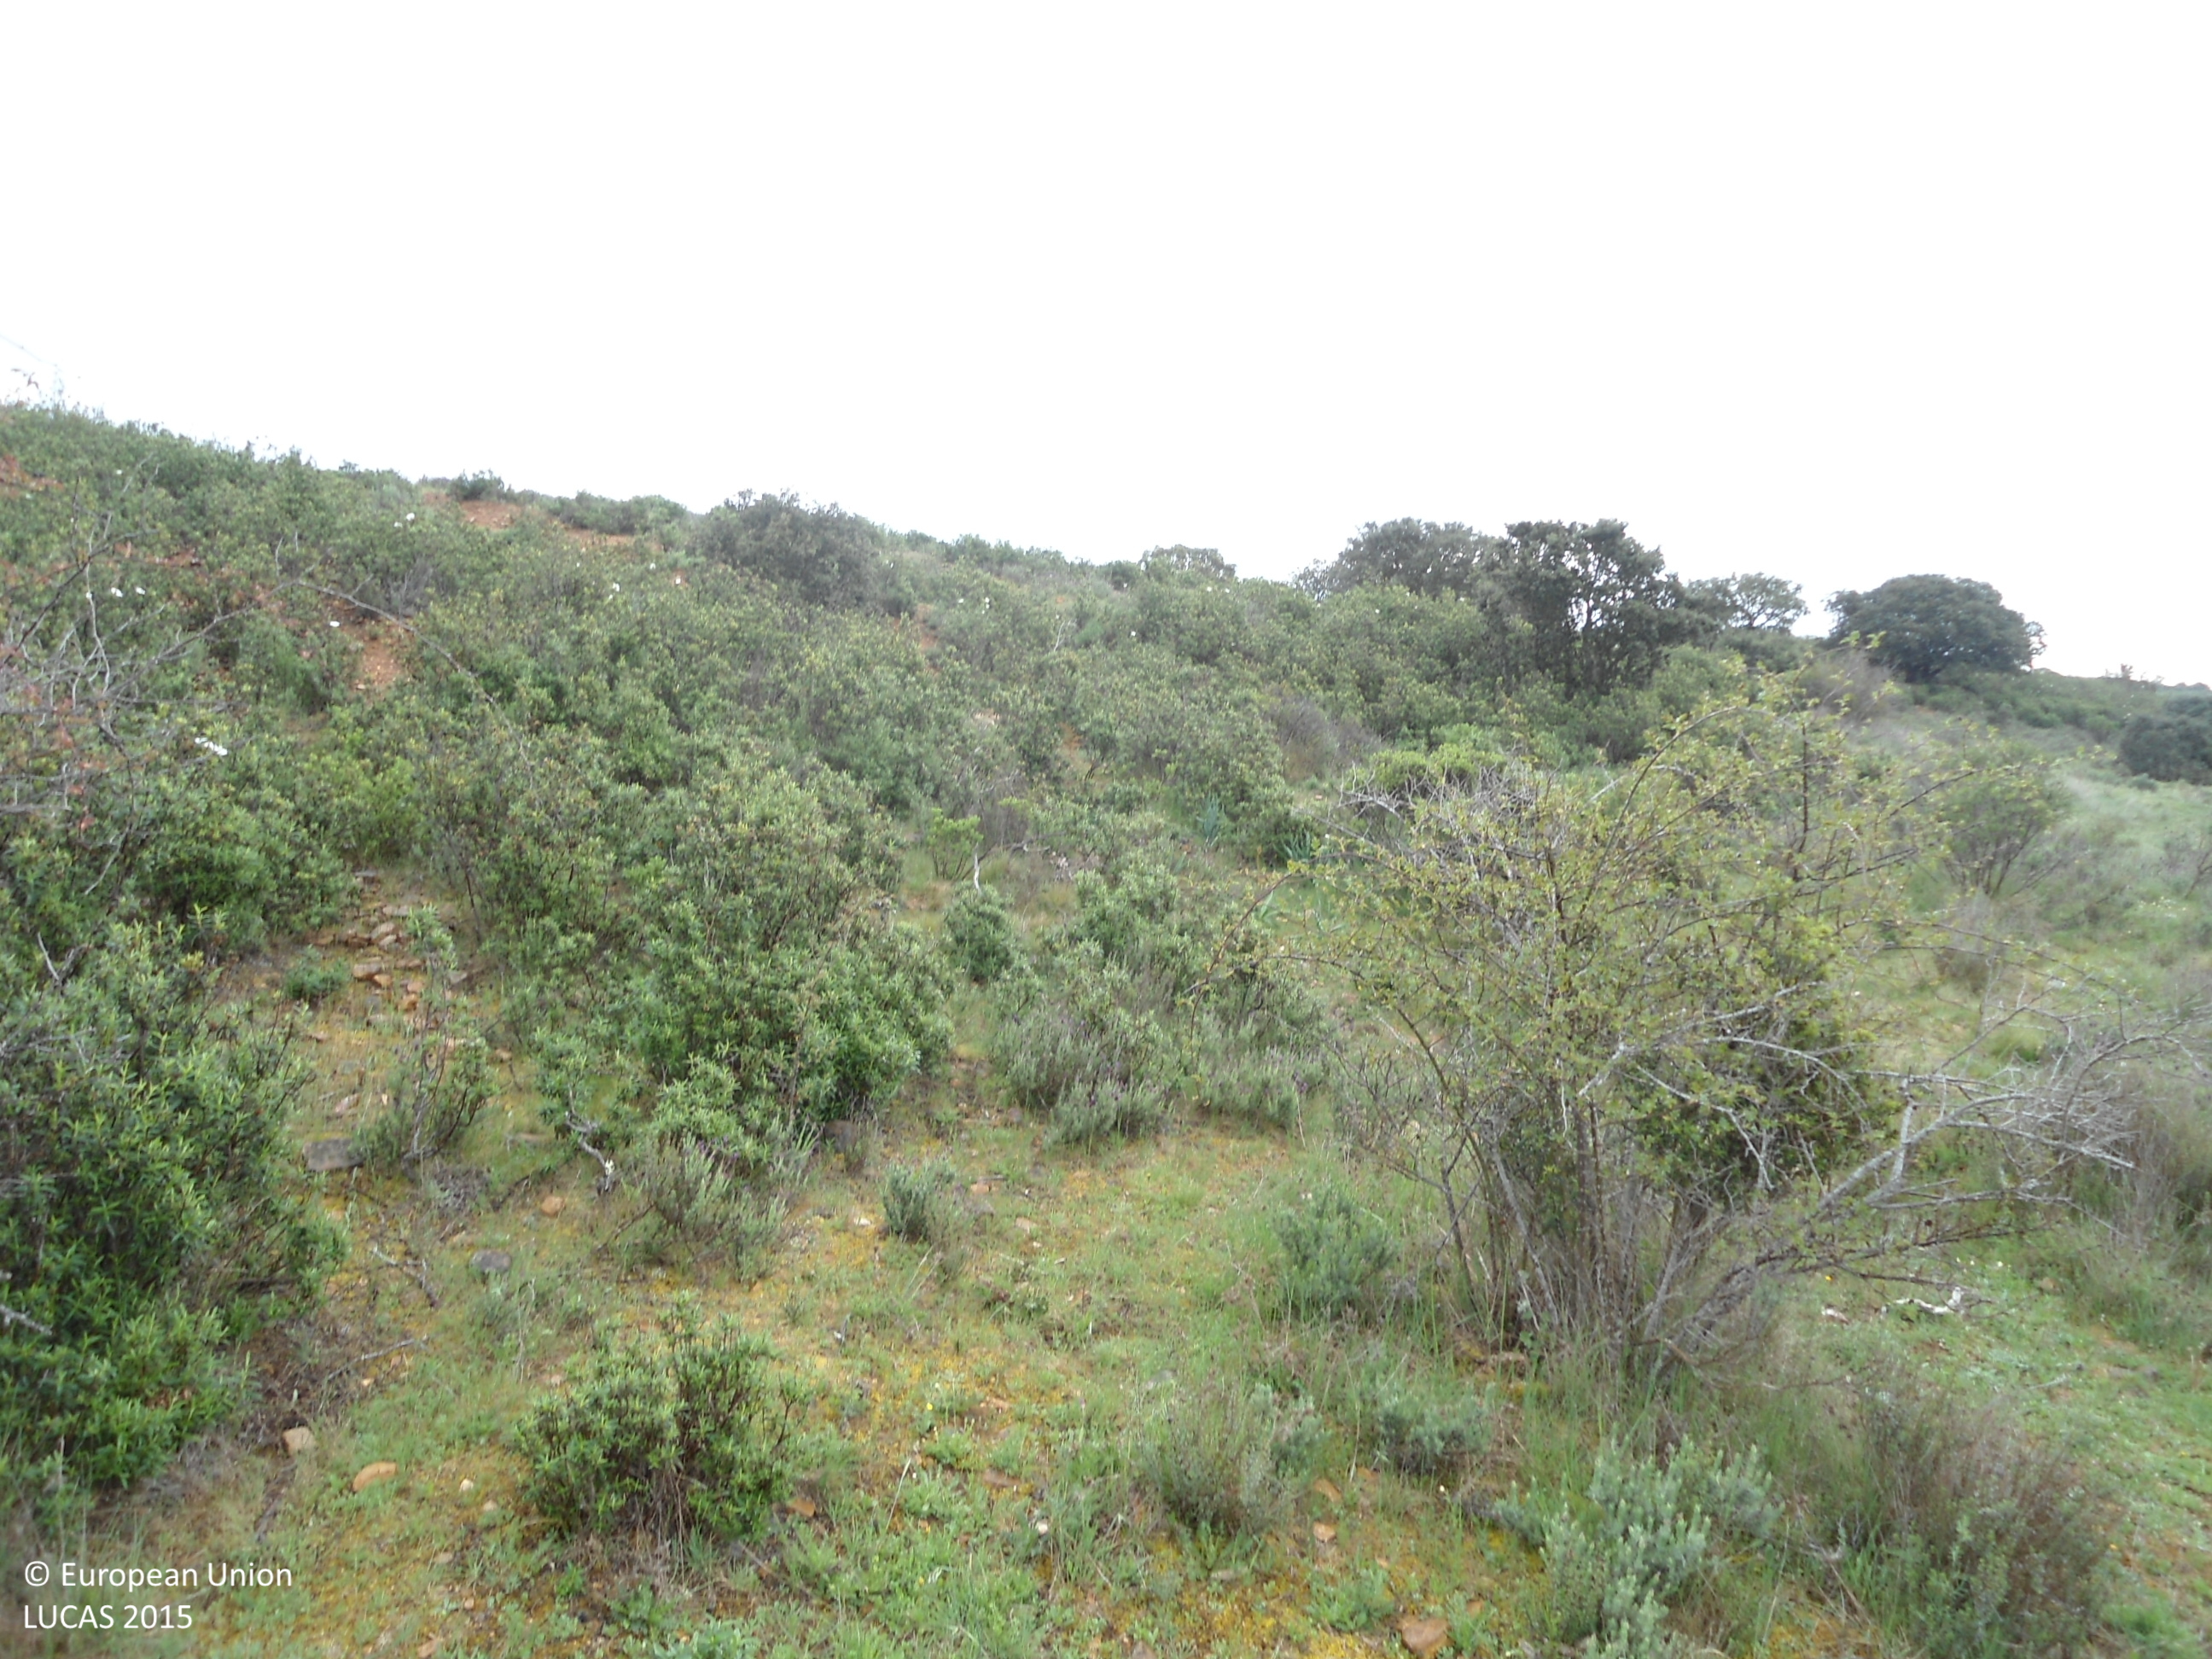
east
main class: Shrubland
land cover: Shrubland without tree cover
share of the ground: > 75 %
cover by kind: shrubs 80 %, herbaceous plants 20 %
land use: Agriculture (excluding fallow land and kitchen gardens)
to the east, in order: Shrubland without tree cover; Shrubland with sparse tree cover; Spontaneously vegetated surfaces; Grassland without tree/shrub cover; Shrubland without tree cover
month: April
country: ES
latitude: 41.7271
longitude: -5.8520
